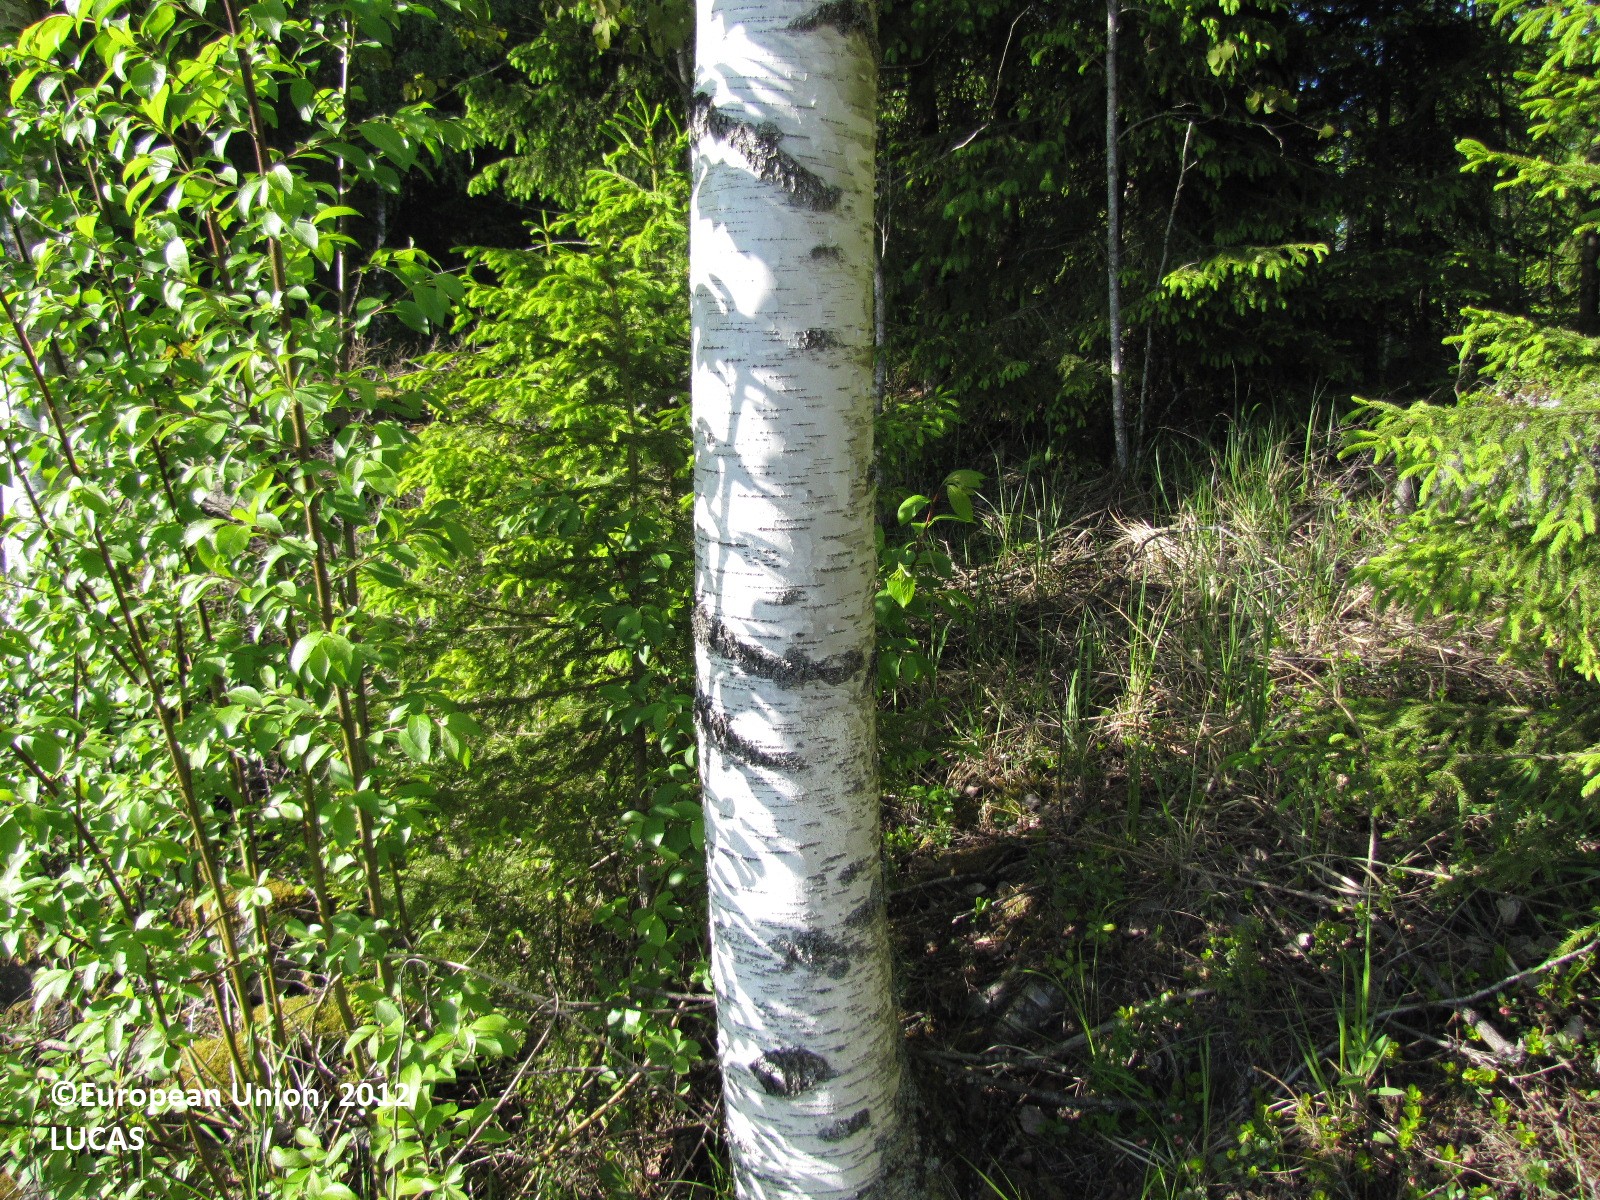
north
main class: Cropland
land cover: Barley
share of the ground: 25 - 50 %
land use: Agriculture (excluding fallow land and kitchen gardens)
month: June
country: FI
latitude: 61.2415
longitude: 22.9850
